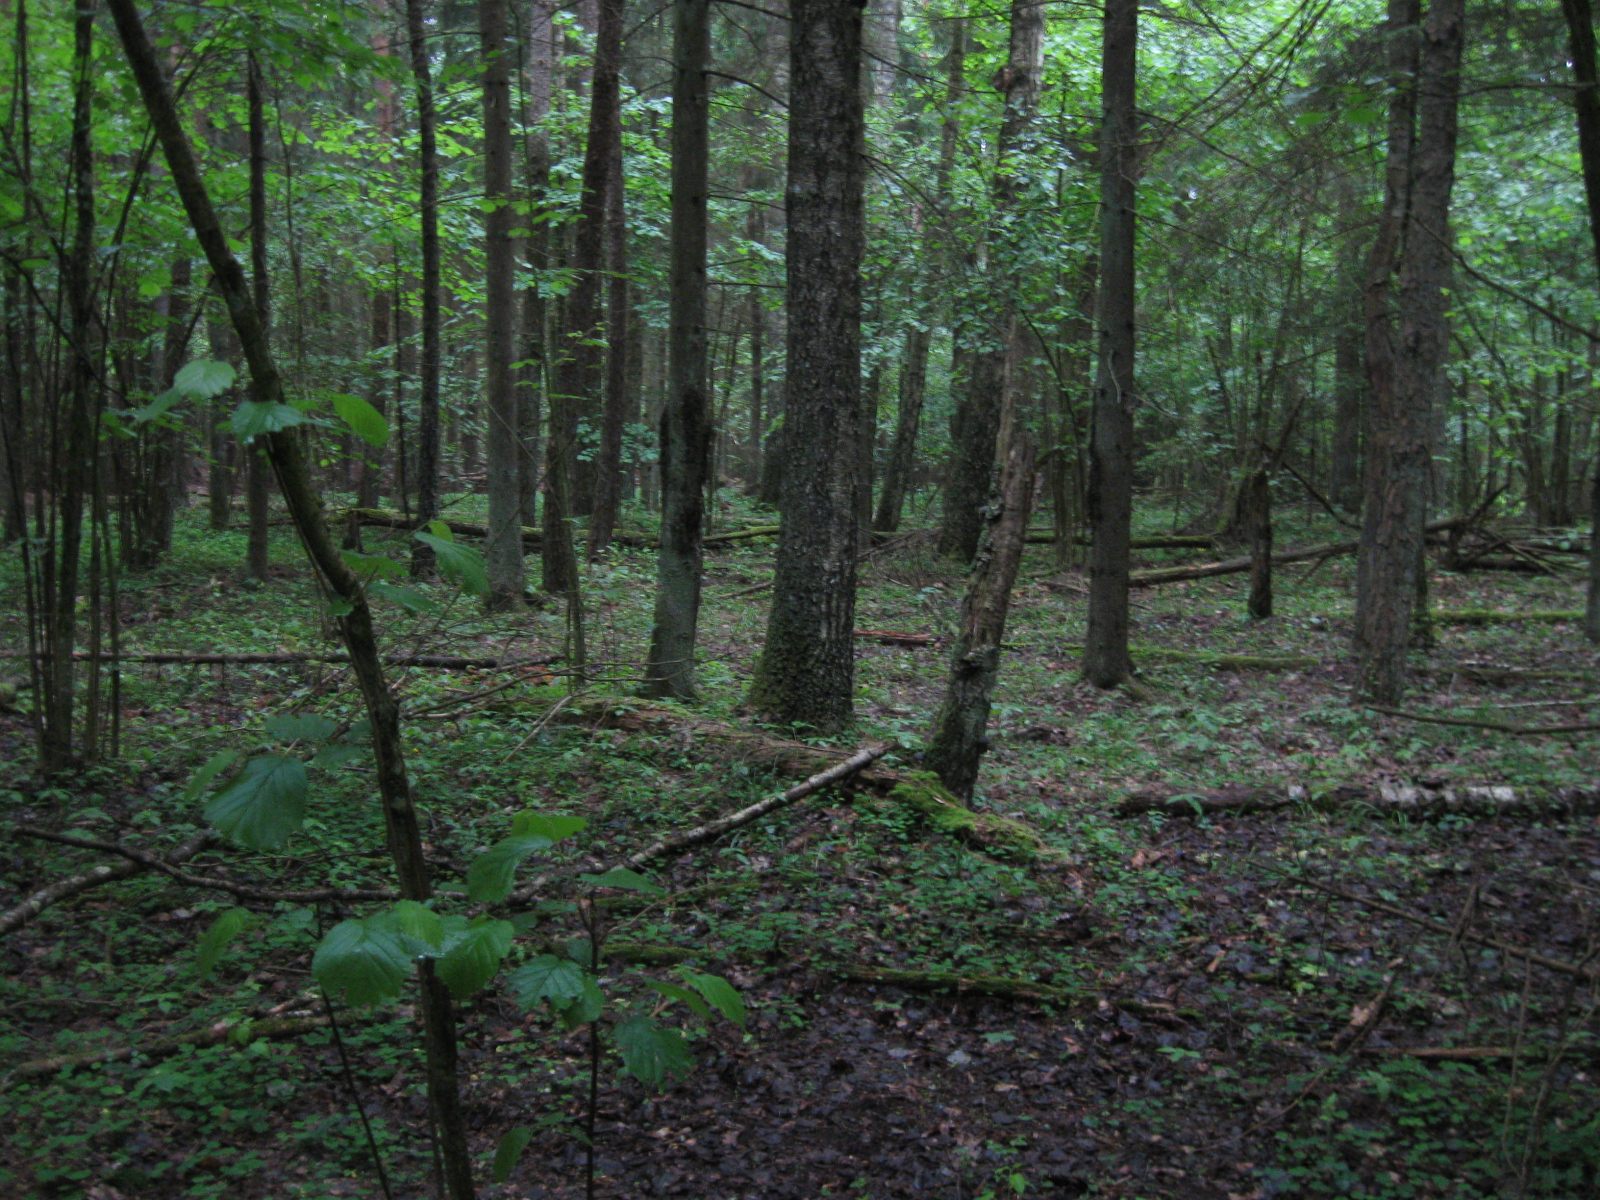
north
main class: Woodland
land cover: Spruce dominated mixed woodland
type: hemiboreal forest and nemoral coniferous forest and mixed broadleaved-coniferous forest
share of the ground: > 75 %
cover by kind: coniferous forest trees 60 %, broadleaved forest trees 35 %, herbaceous plants 5 %
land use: Forestry
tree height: > 5 m
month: June
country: LT
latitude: 54.8235
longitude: 24.5314
